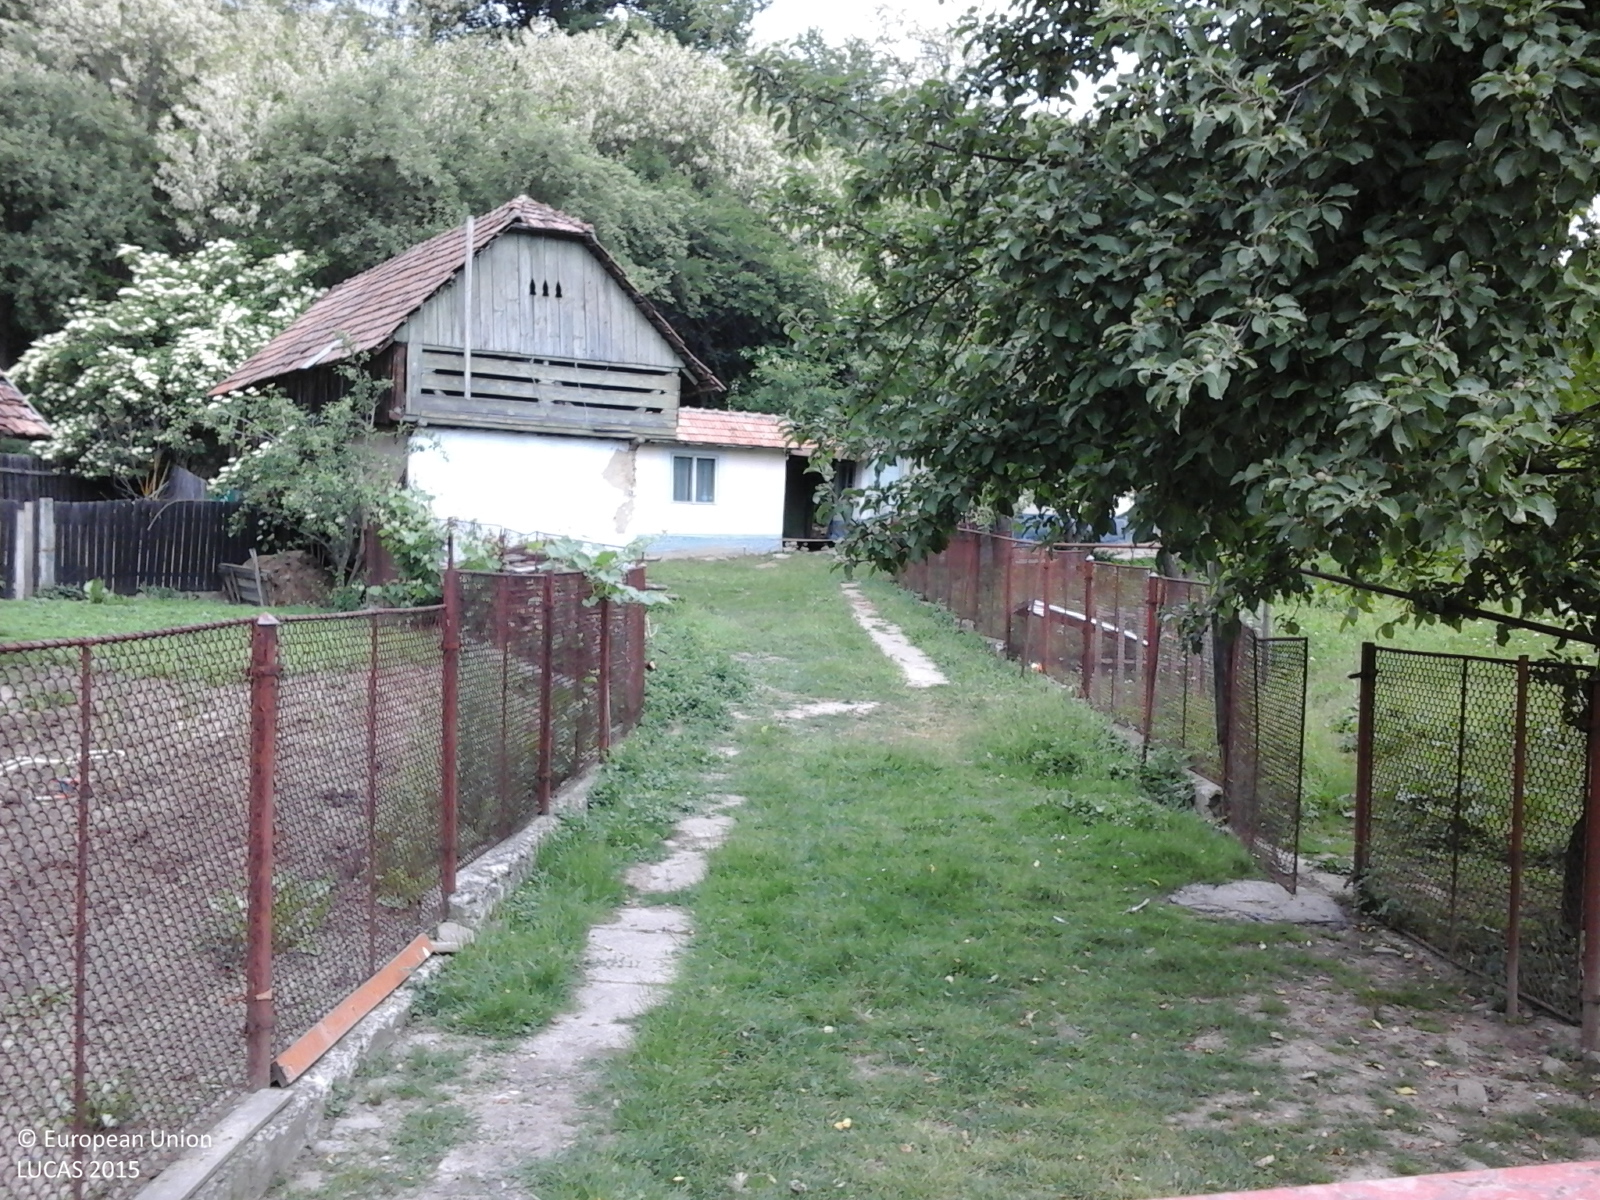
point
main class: Grassland
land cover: Grassland without tree/shrub cover
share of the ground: > 75 %
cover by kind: herbaceous plants 100 %
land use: Residential
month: June
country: RO
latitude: 46.4586
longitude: 26.4736
